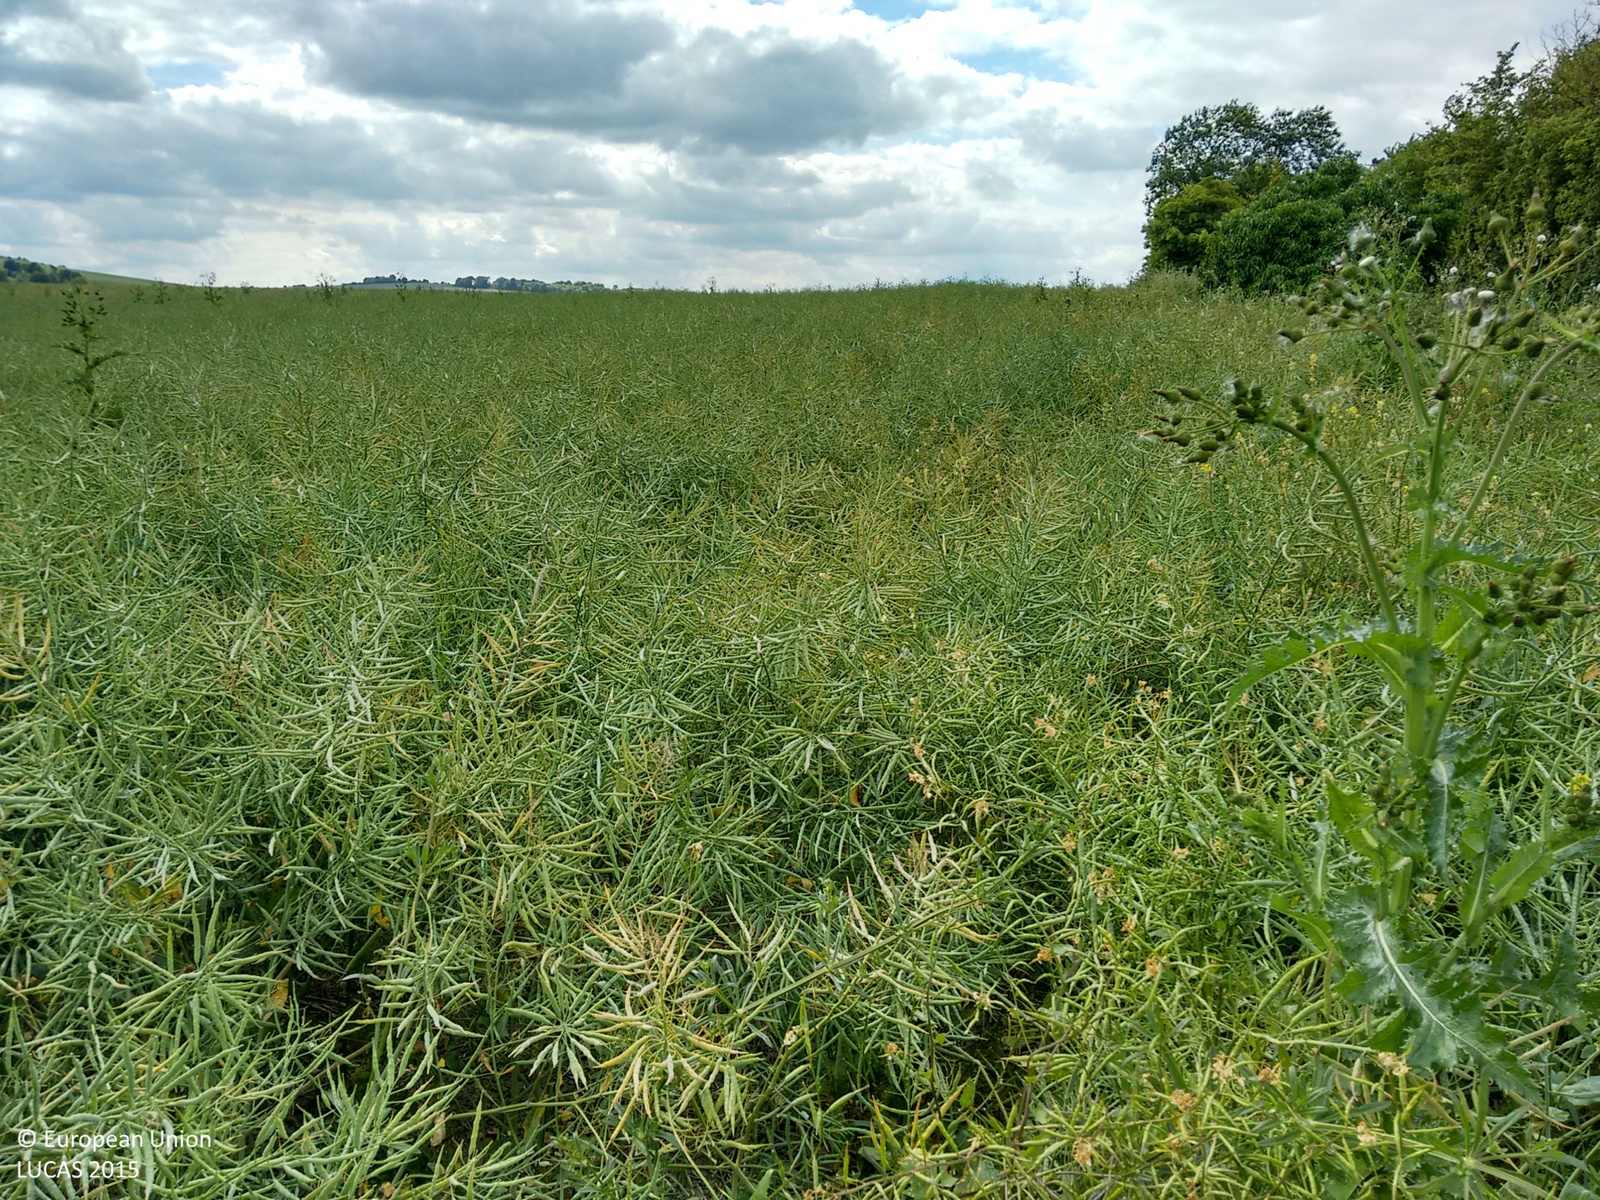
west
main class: Cropland
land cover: Rape and turnip rape
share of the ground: > 75 %
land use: Agriculture (excluding fallow land and kitchen gardens)
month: June
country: GB
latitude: 51.5808
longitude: -1.4950
